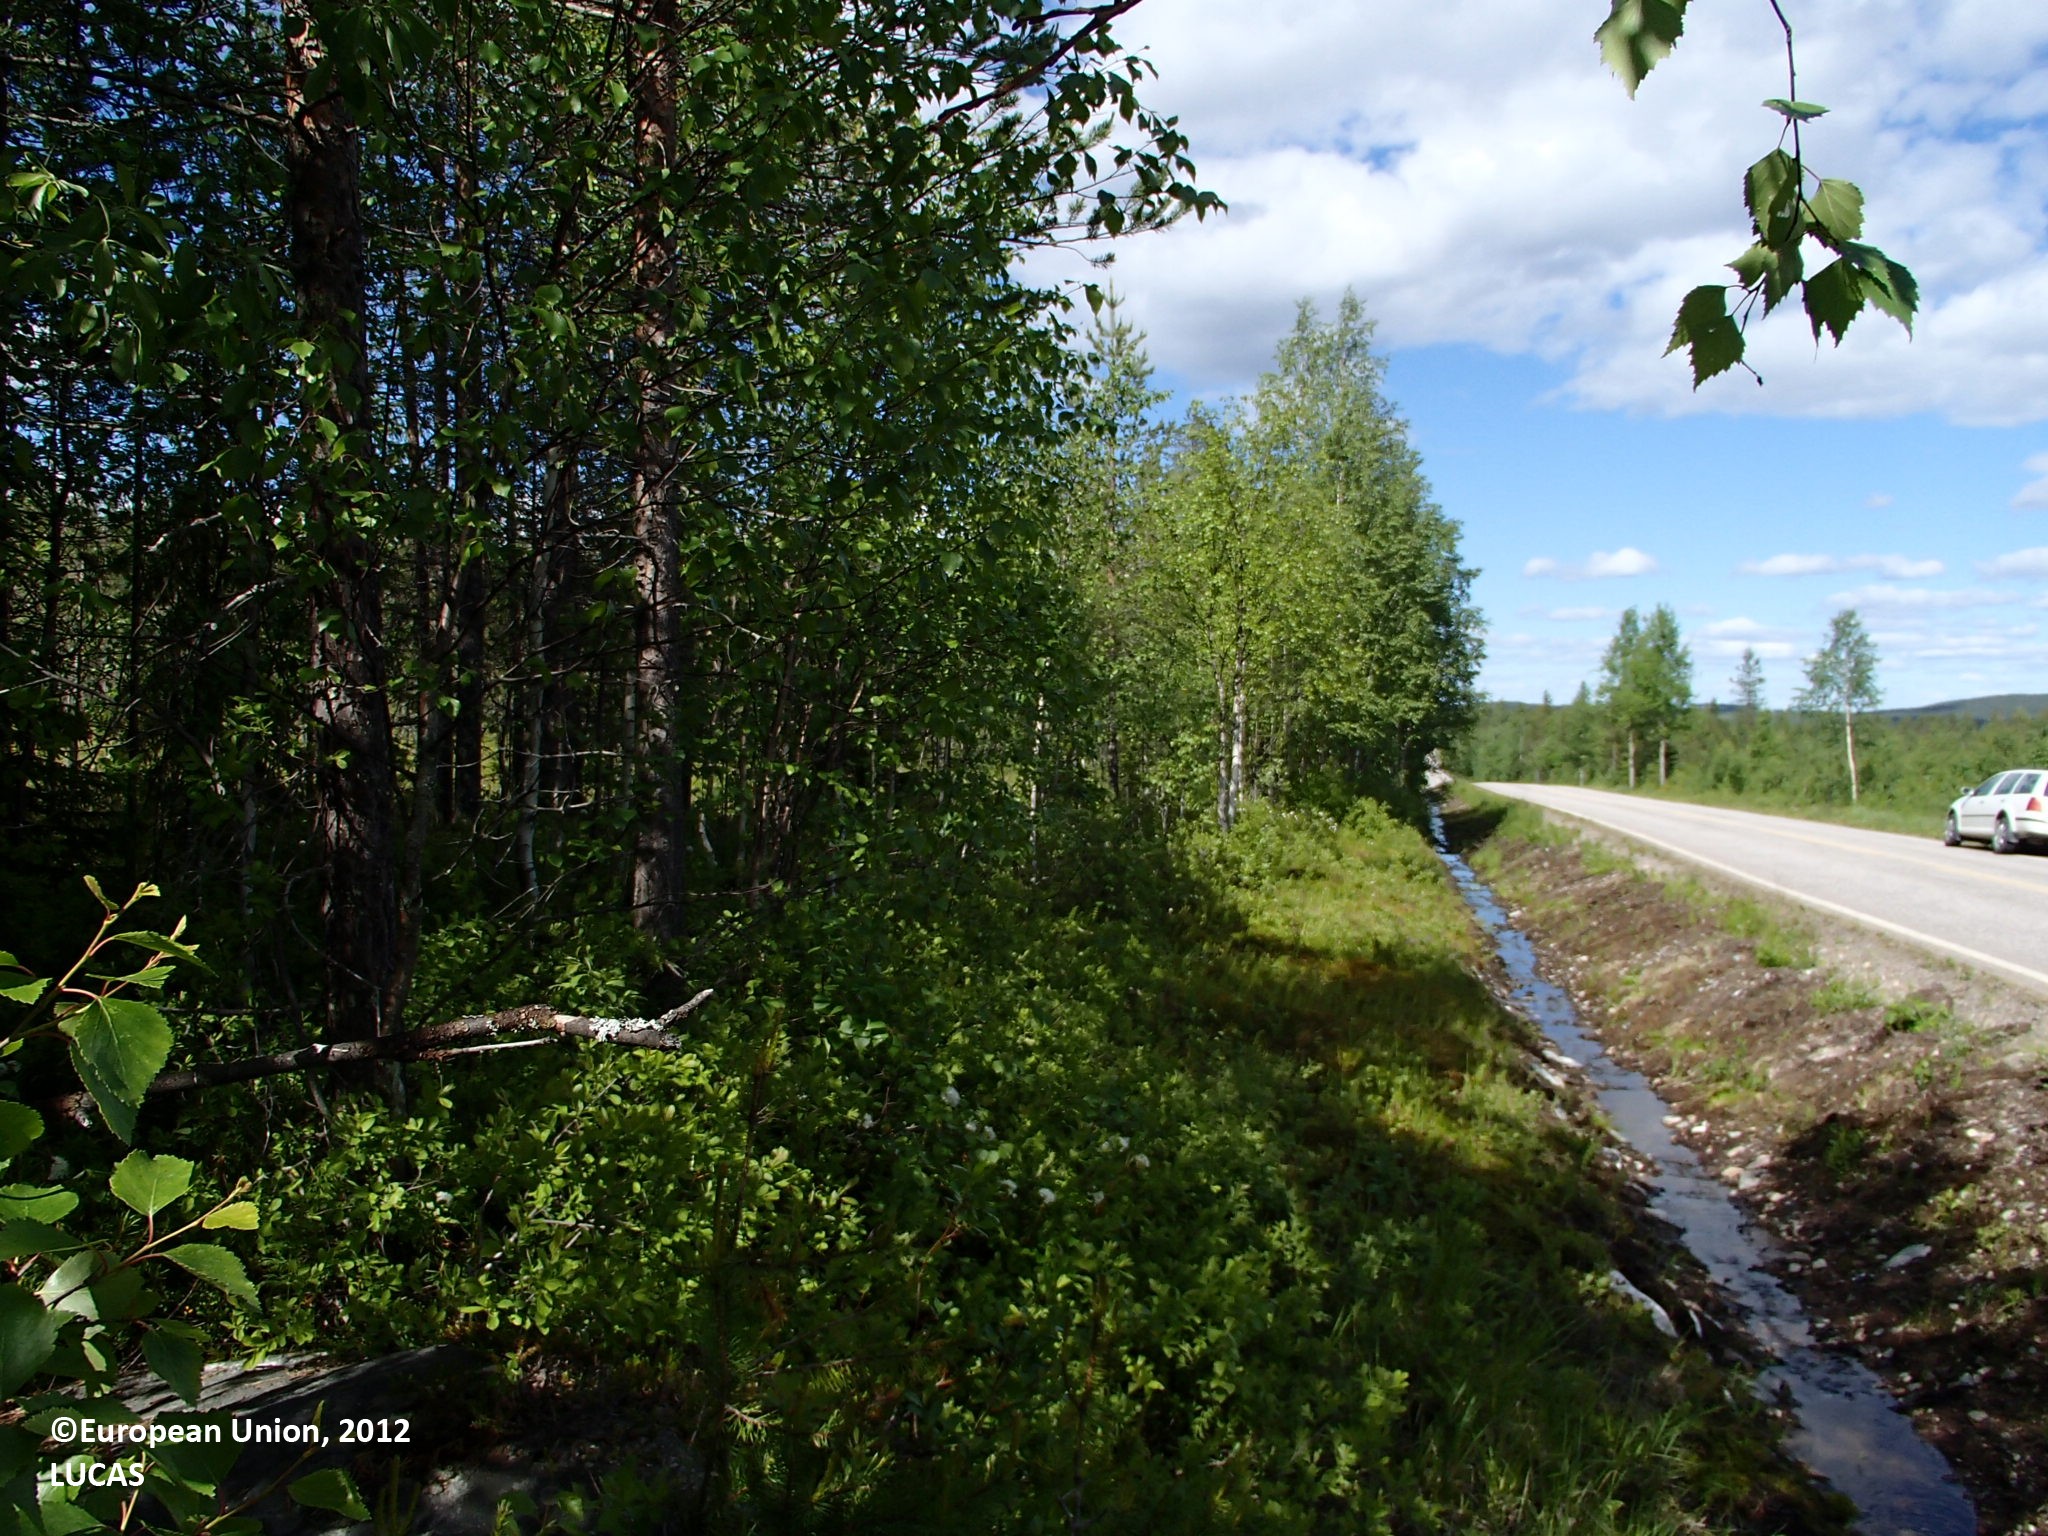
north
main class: Woodland
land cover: Other mixed woodland
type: boreal forest
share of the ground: > 75 %
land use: Forestry
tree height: > 5 m
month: June
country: FI
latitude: 66.6522
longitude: 27.3608
